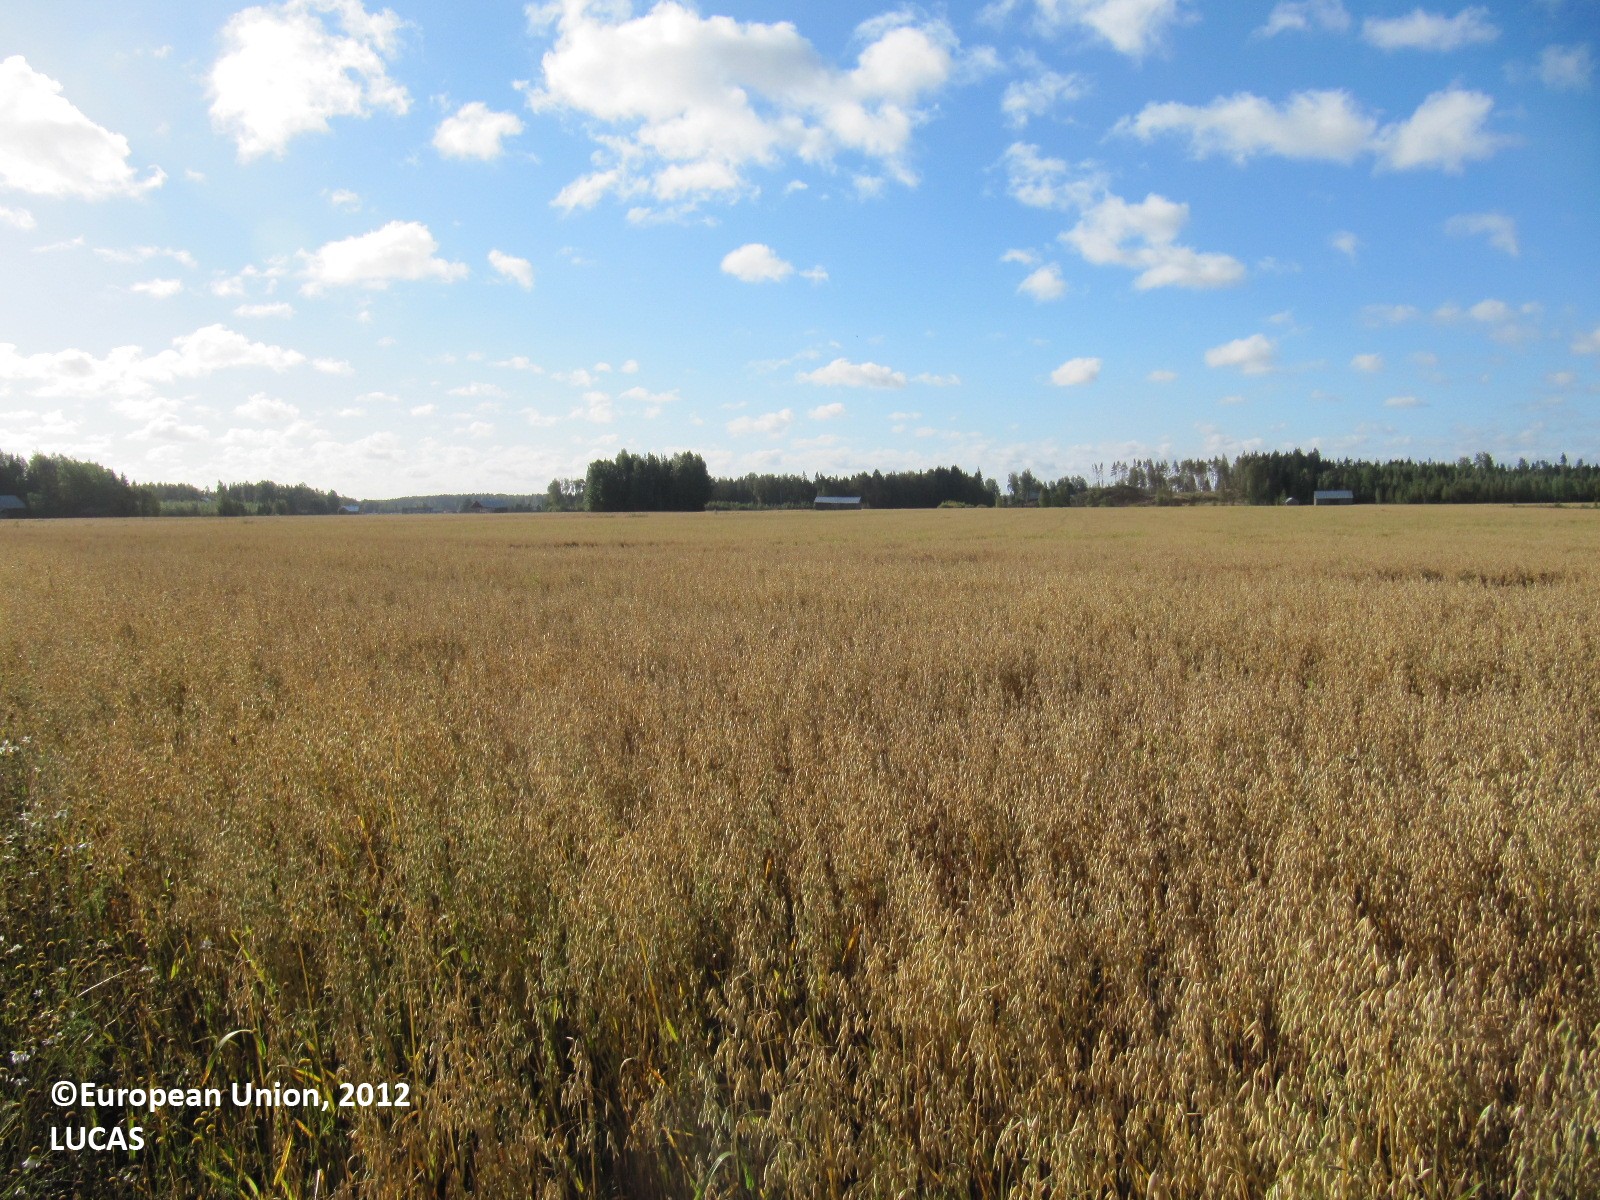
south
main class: Cropland
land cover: Oats
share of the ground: > 75 %
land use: Agriculture (excluding fallow land and kitchen gardens)
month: September
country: FI
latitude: 60.7606
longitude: 23.2394
